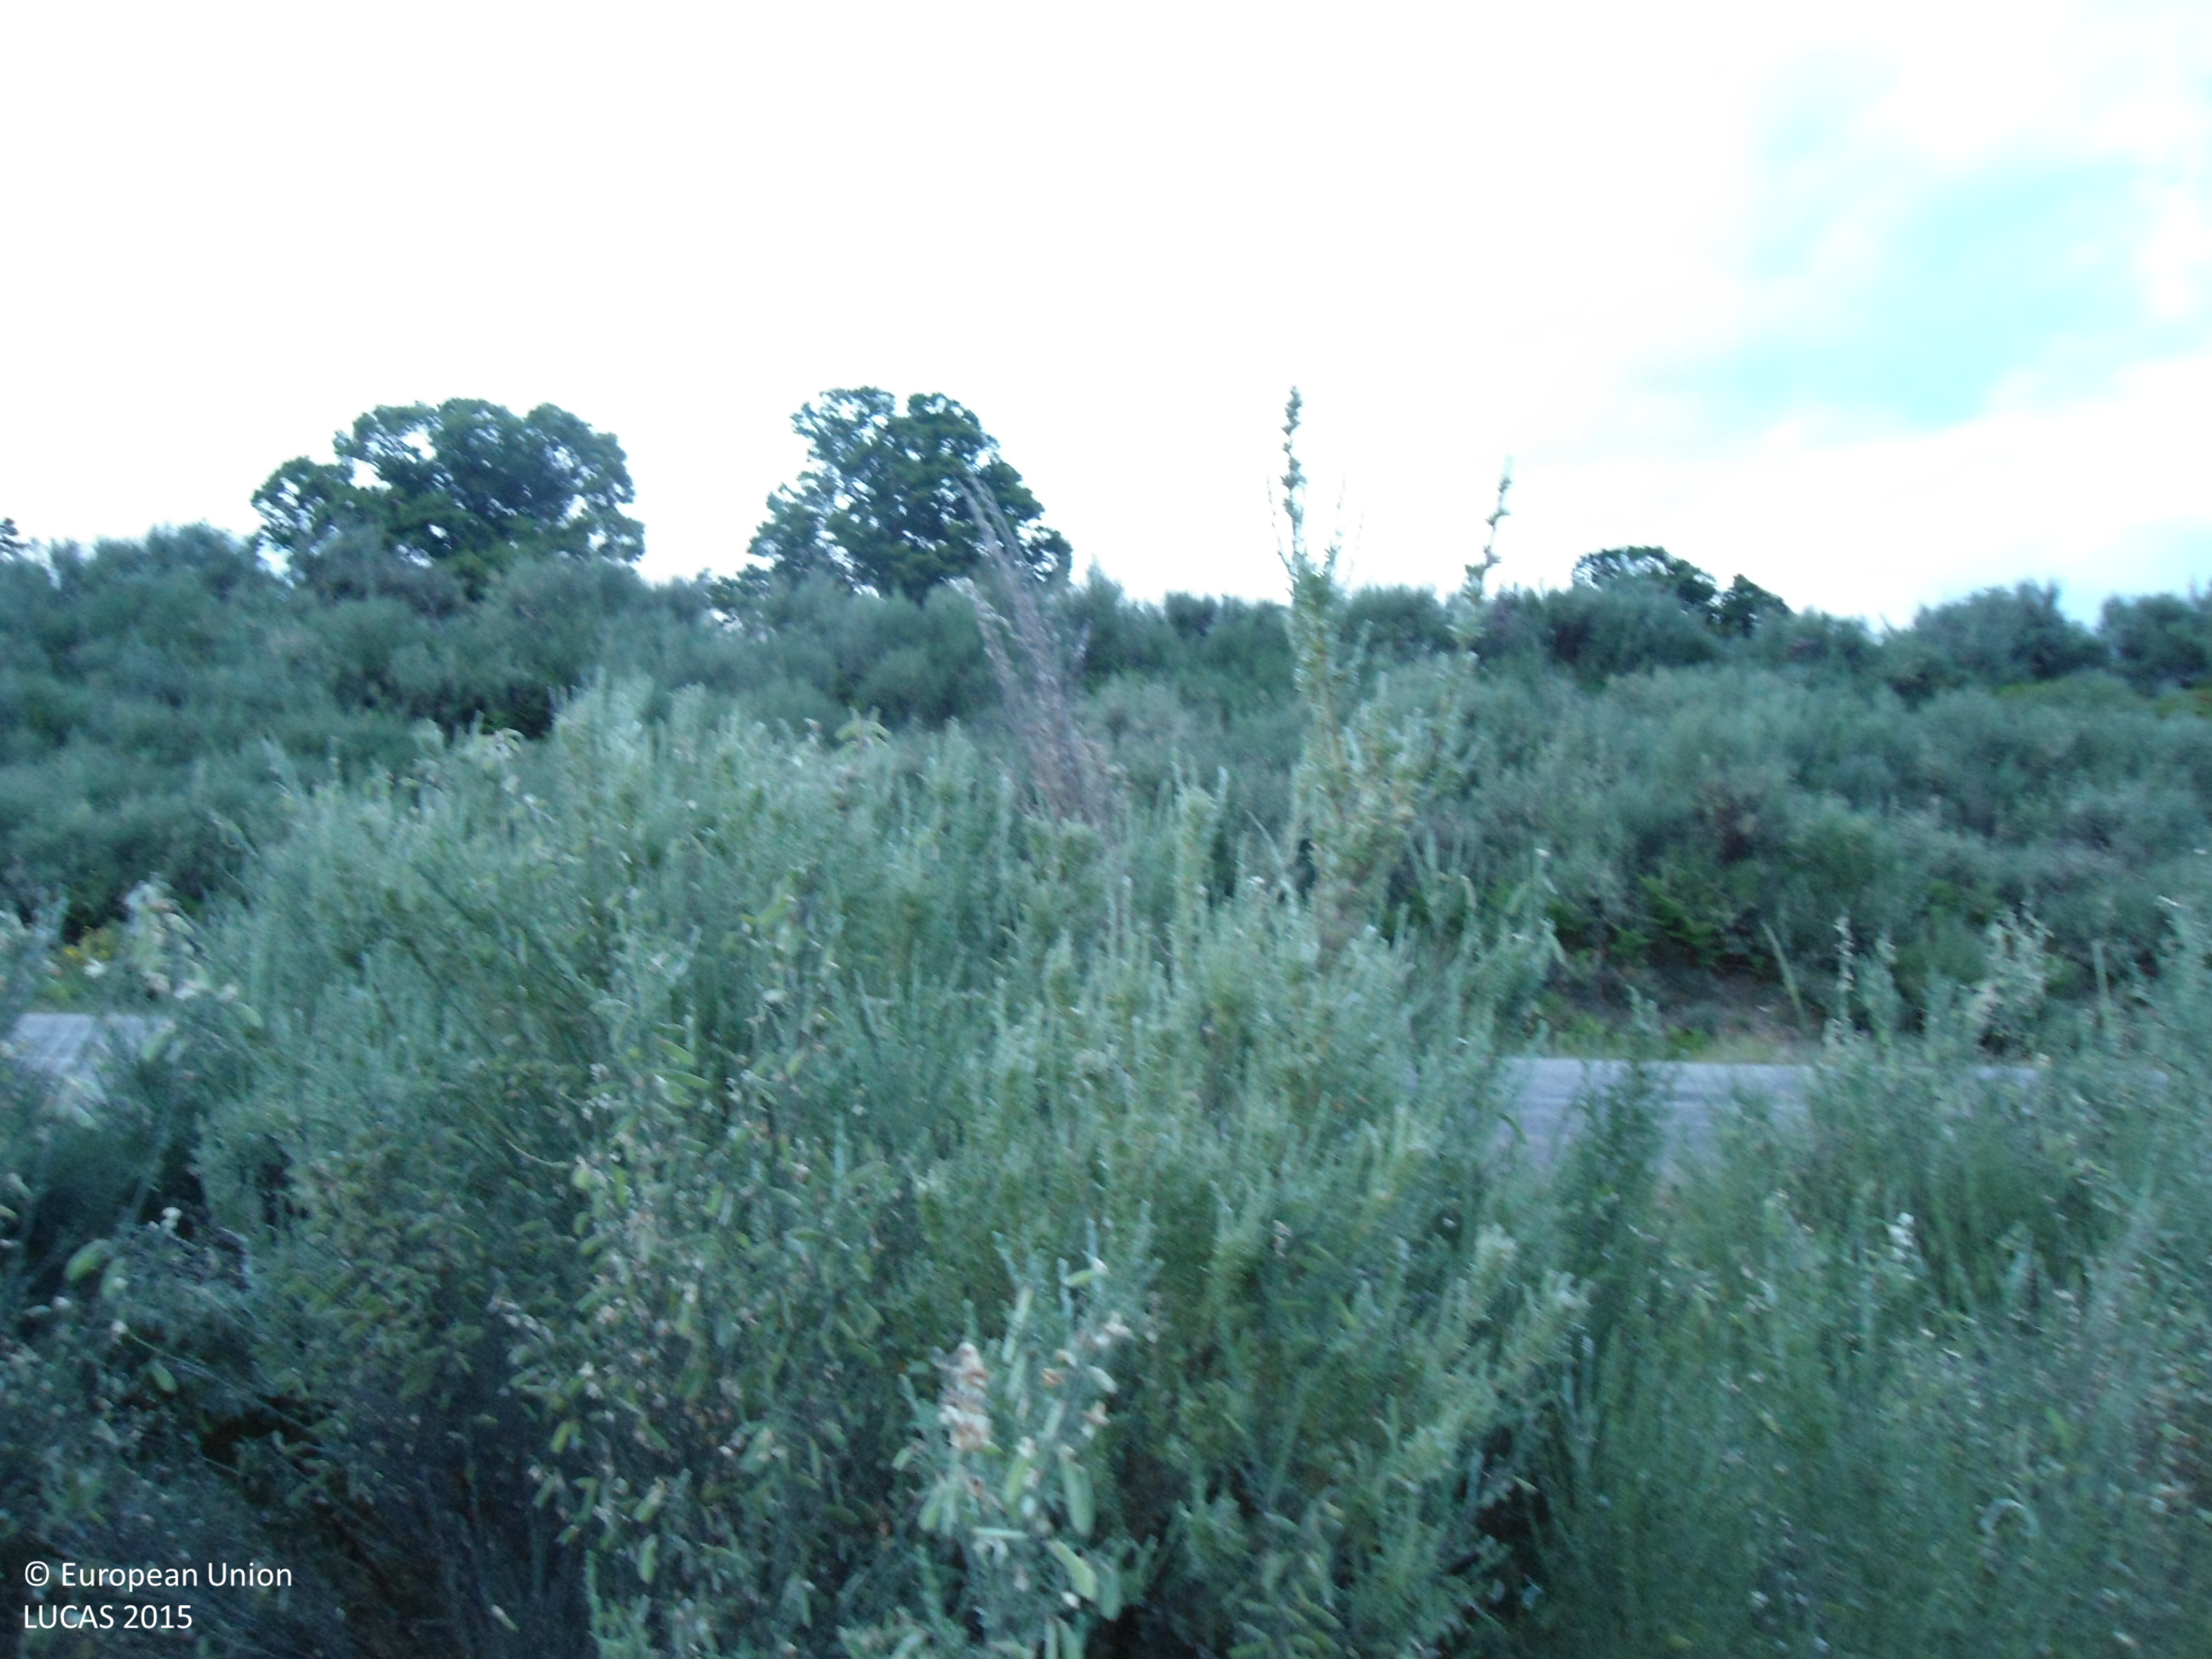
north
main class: Shrubland
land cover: Shrubland without tree cover
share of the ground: > 75 %
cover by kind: shrubs 100 %
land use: Semi-natural and natural areas not in use
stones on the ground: < 10 %
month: June
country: ES
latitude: 42.1505
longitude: -6.6334
